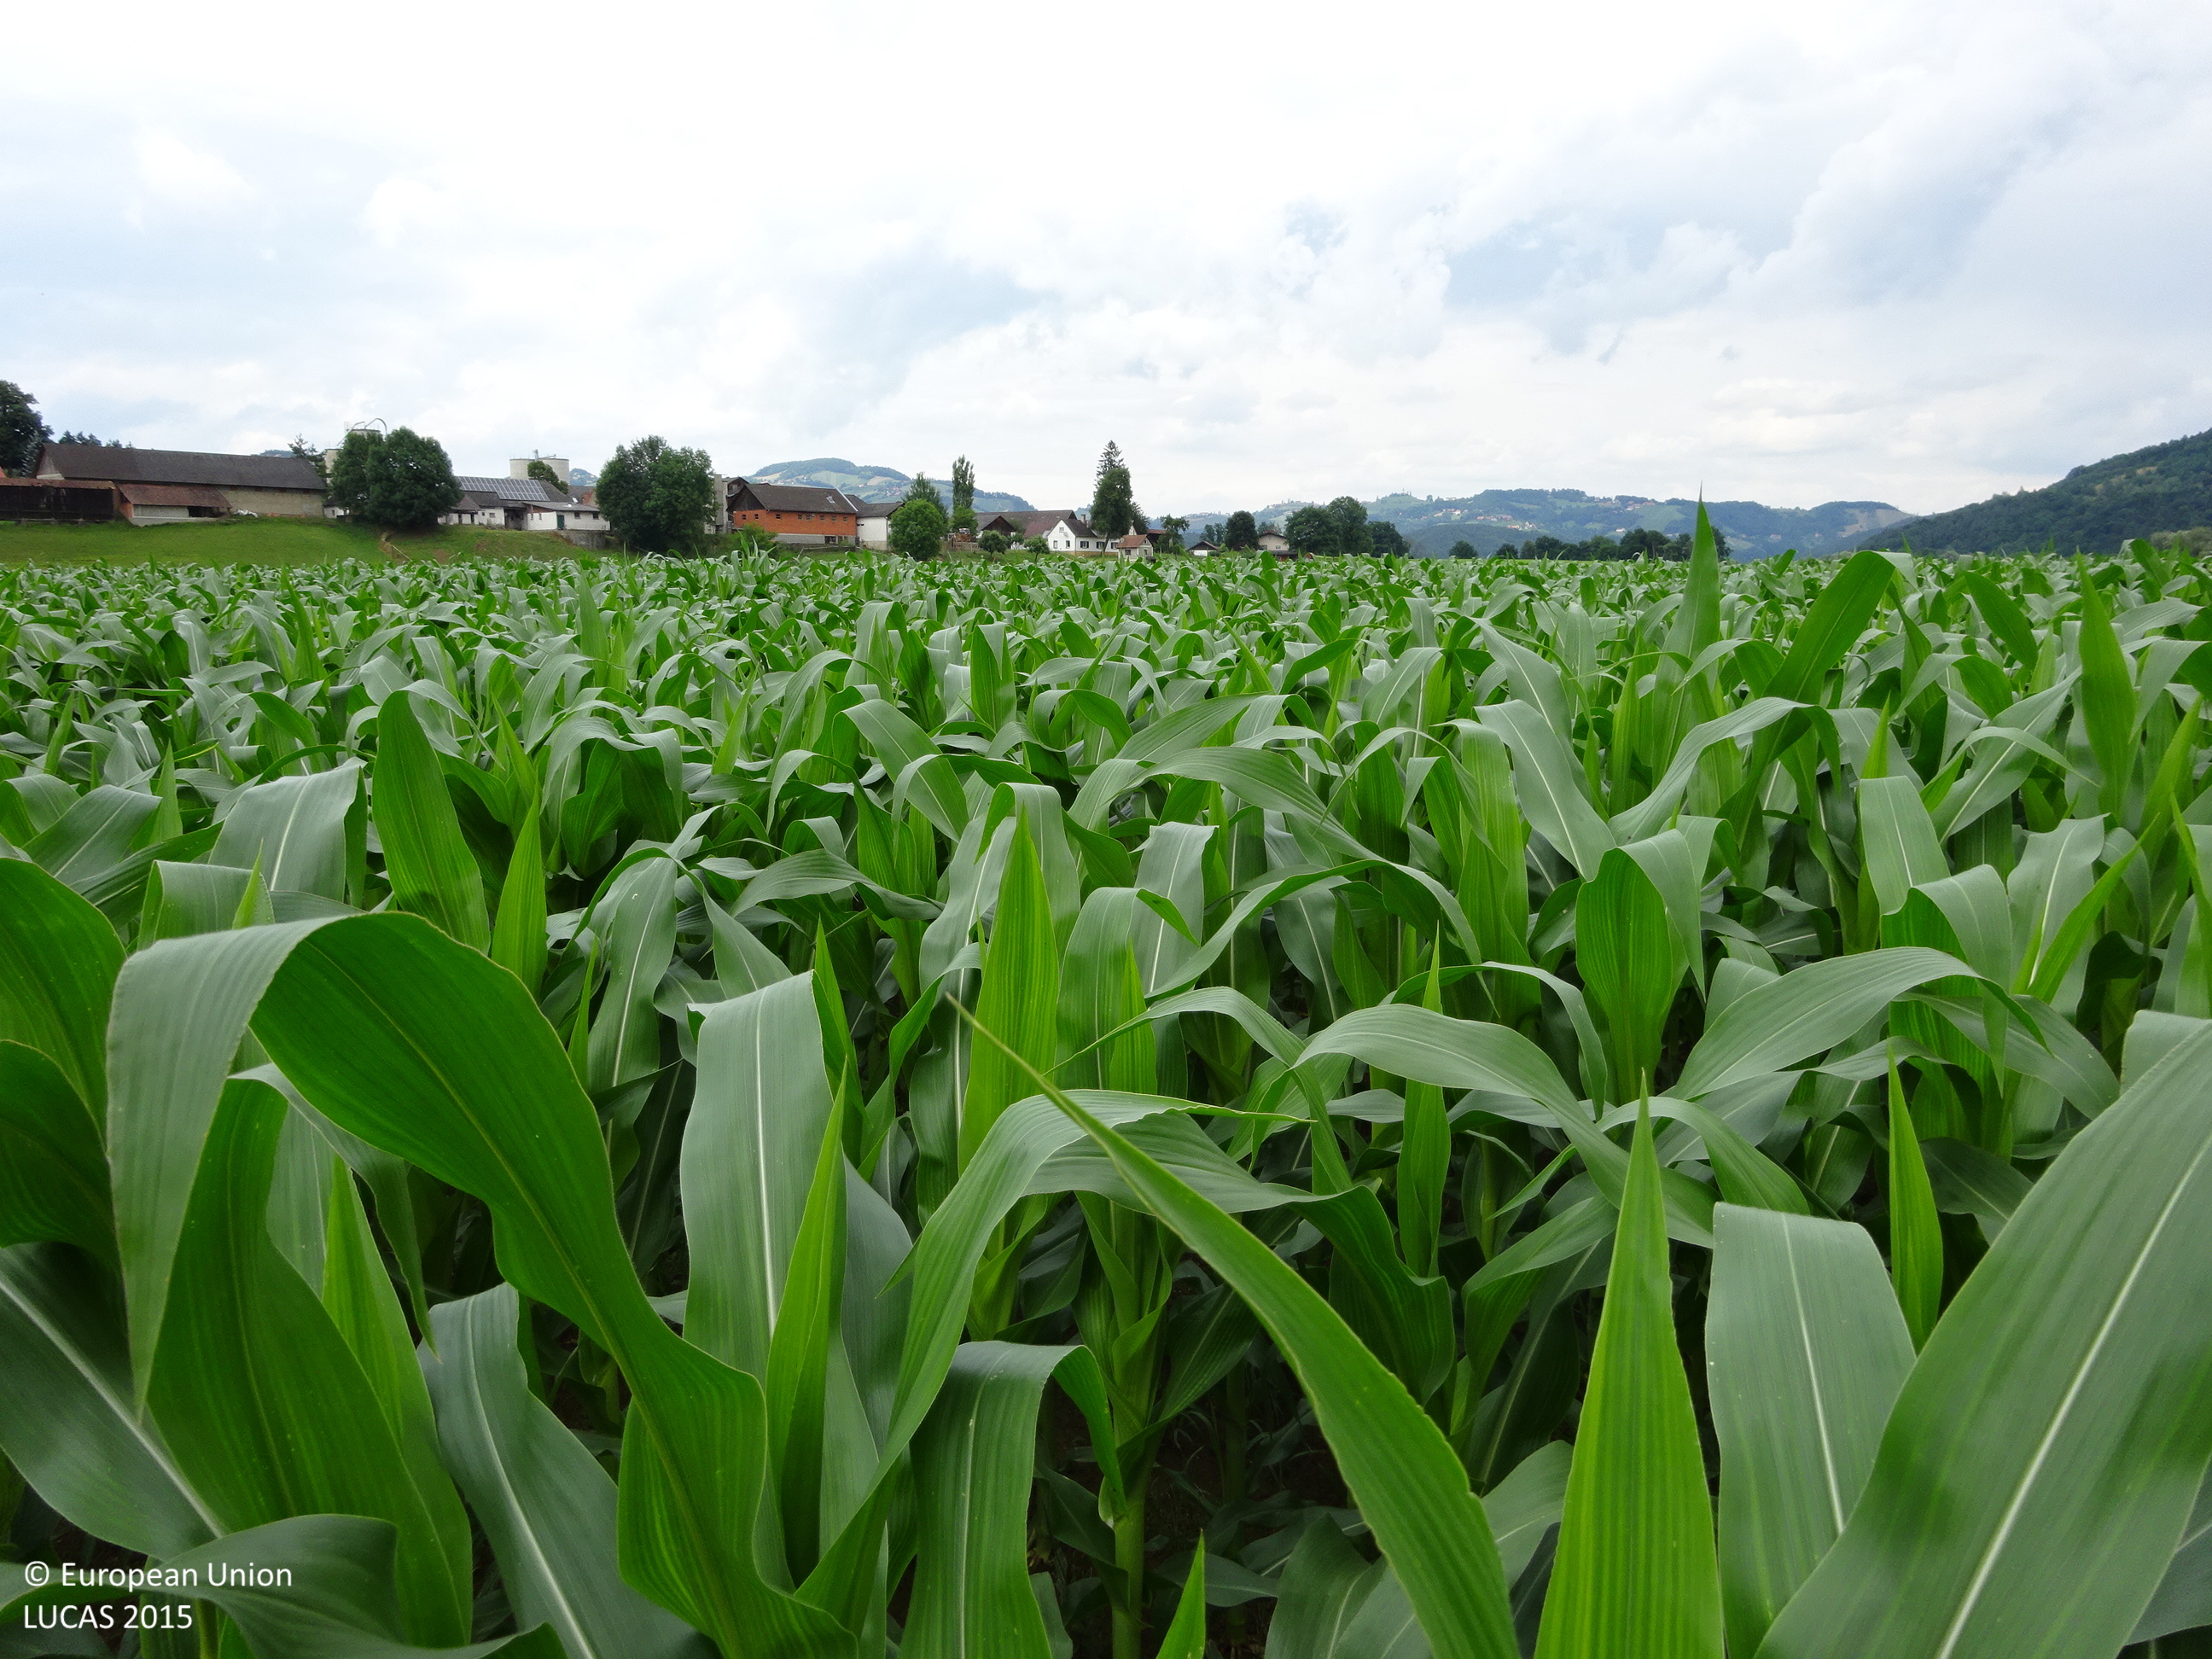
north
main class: Cropland
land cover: Maize
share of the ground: > 75 %
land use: Agriculture (excluding fallow land and kitchen gardens)
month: June
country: AT
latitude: 46.7367
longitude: 15.4302
